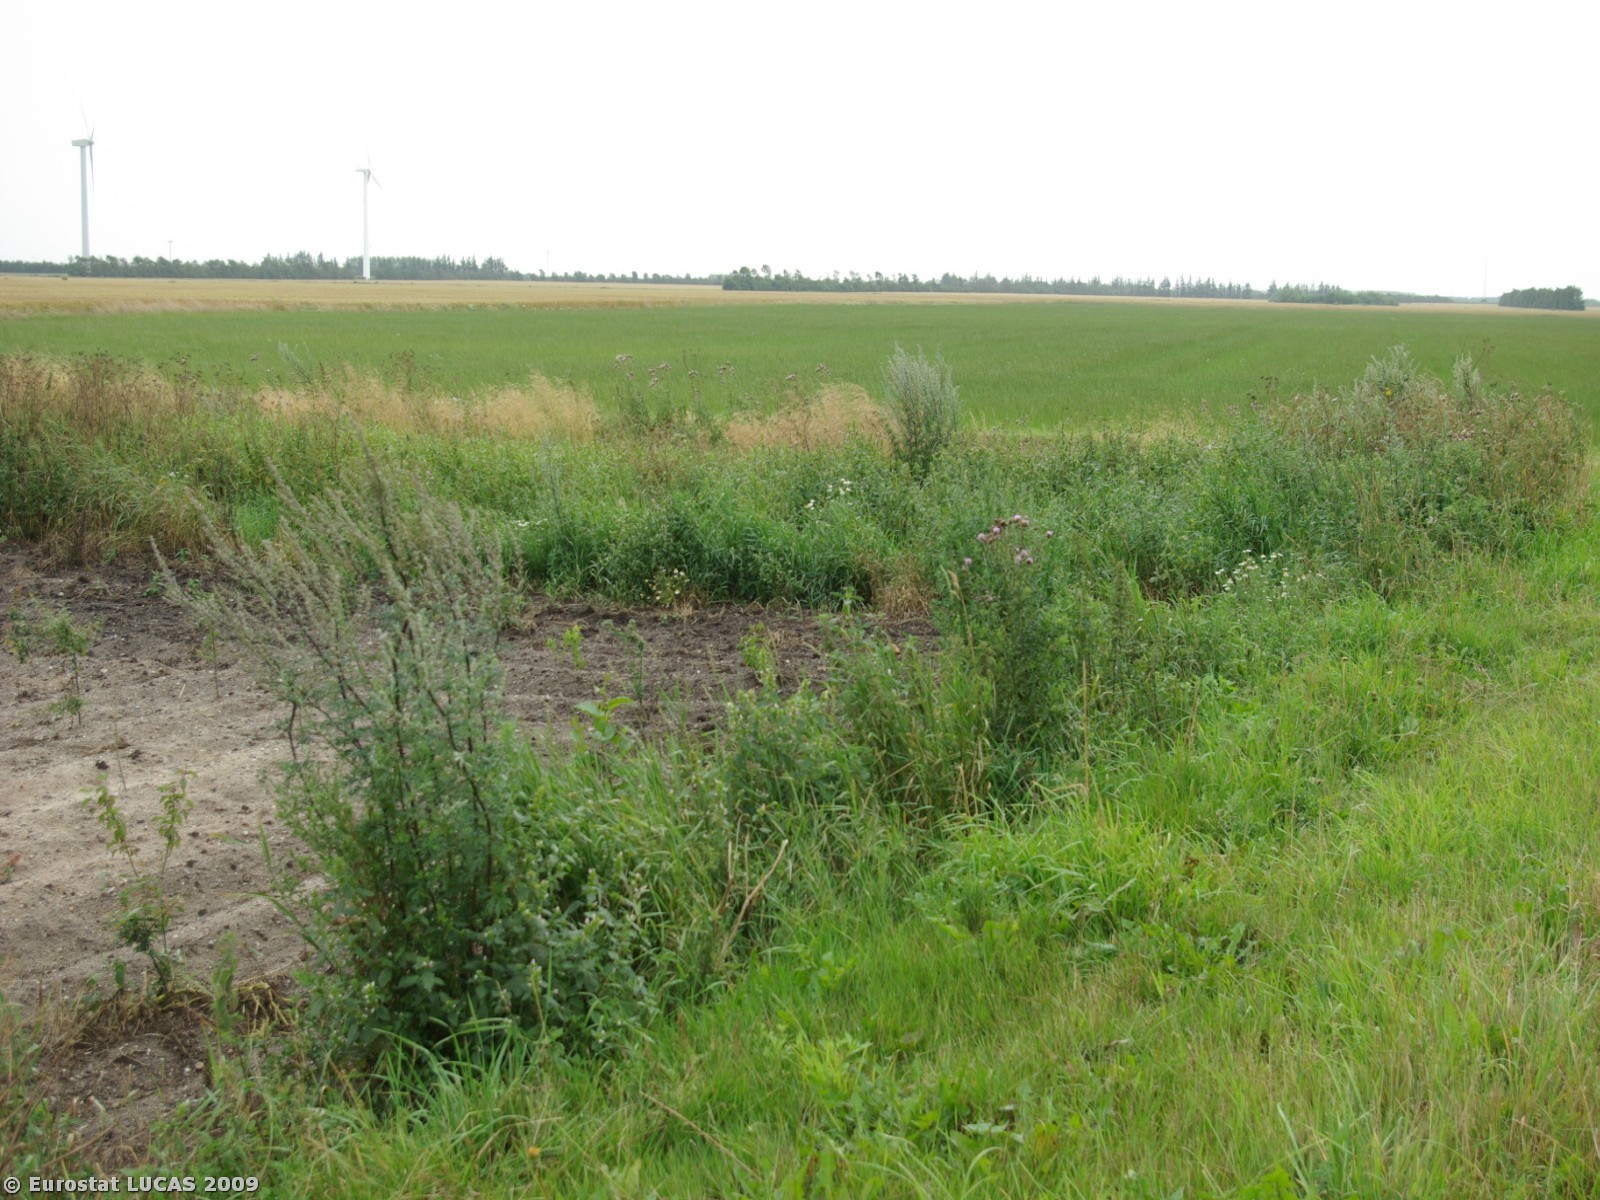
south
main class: Cropland
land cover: Barley
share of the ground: > 75 %
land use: Agriculture (excluding fallow land and kitchen gardens)
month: July
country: DK
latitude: 55.1041
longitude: 8.8567
